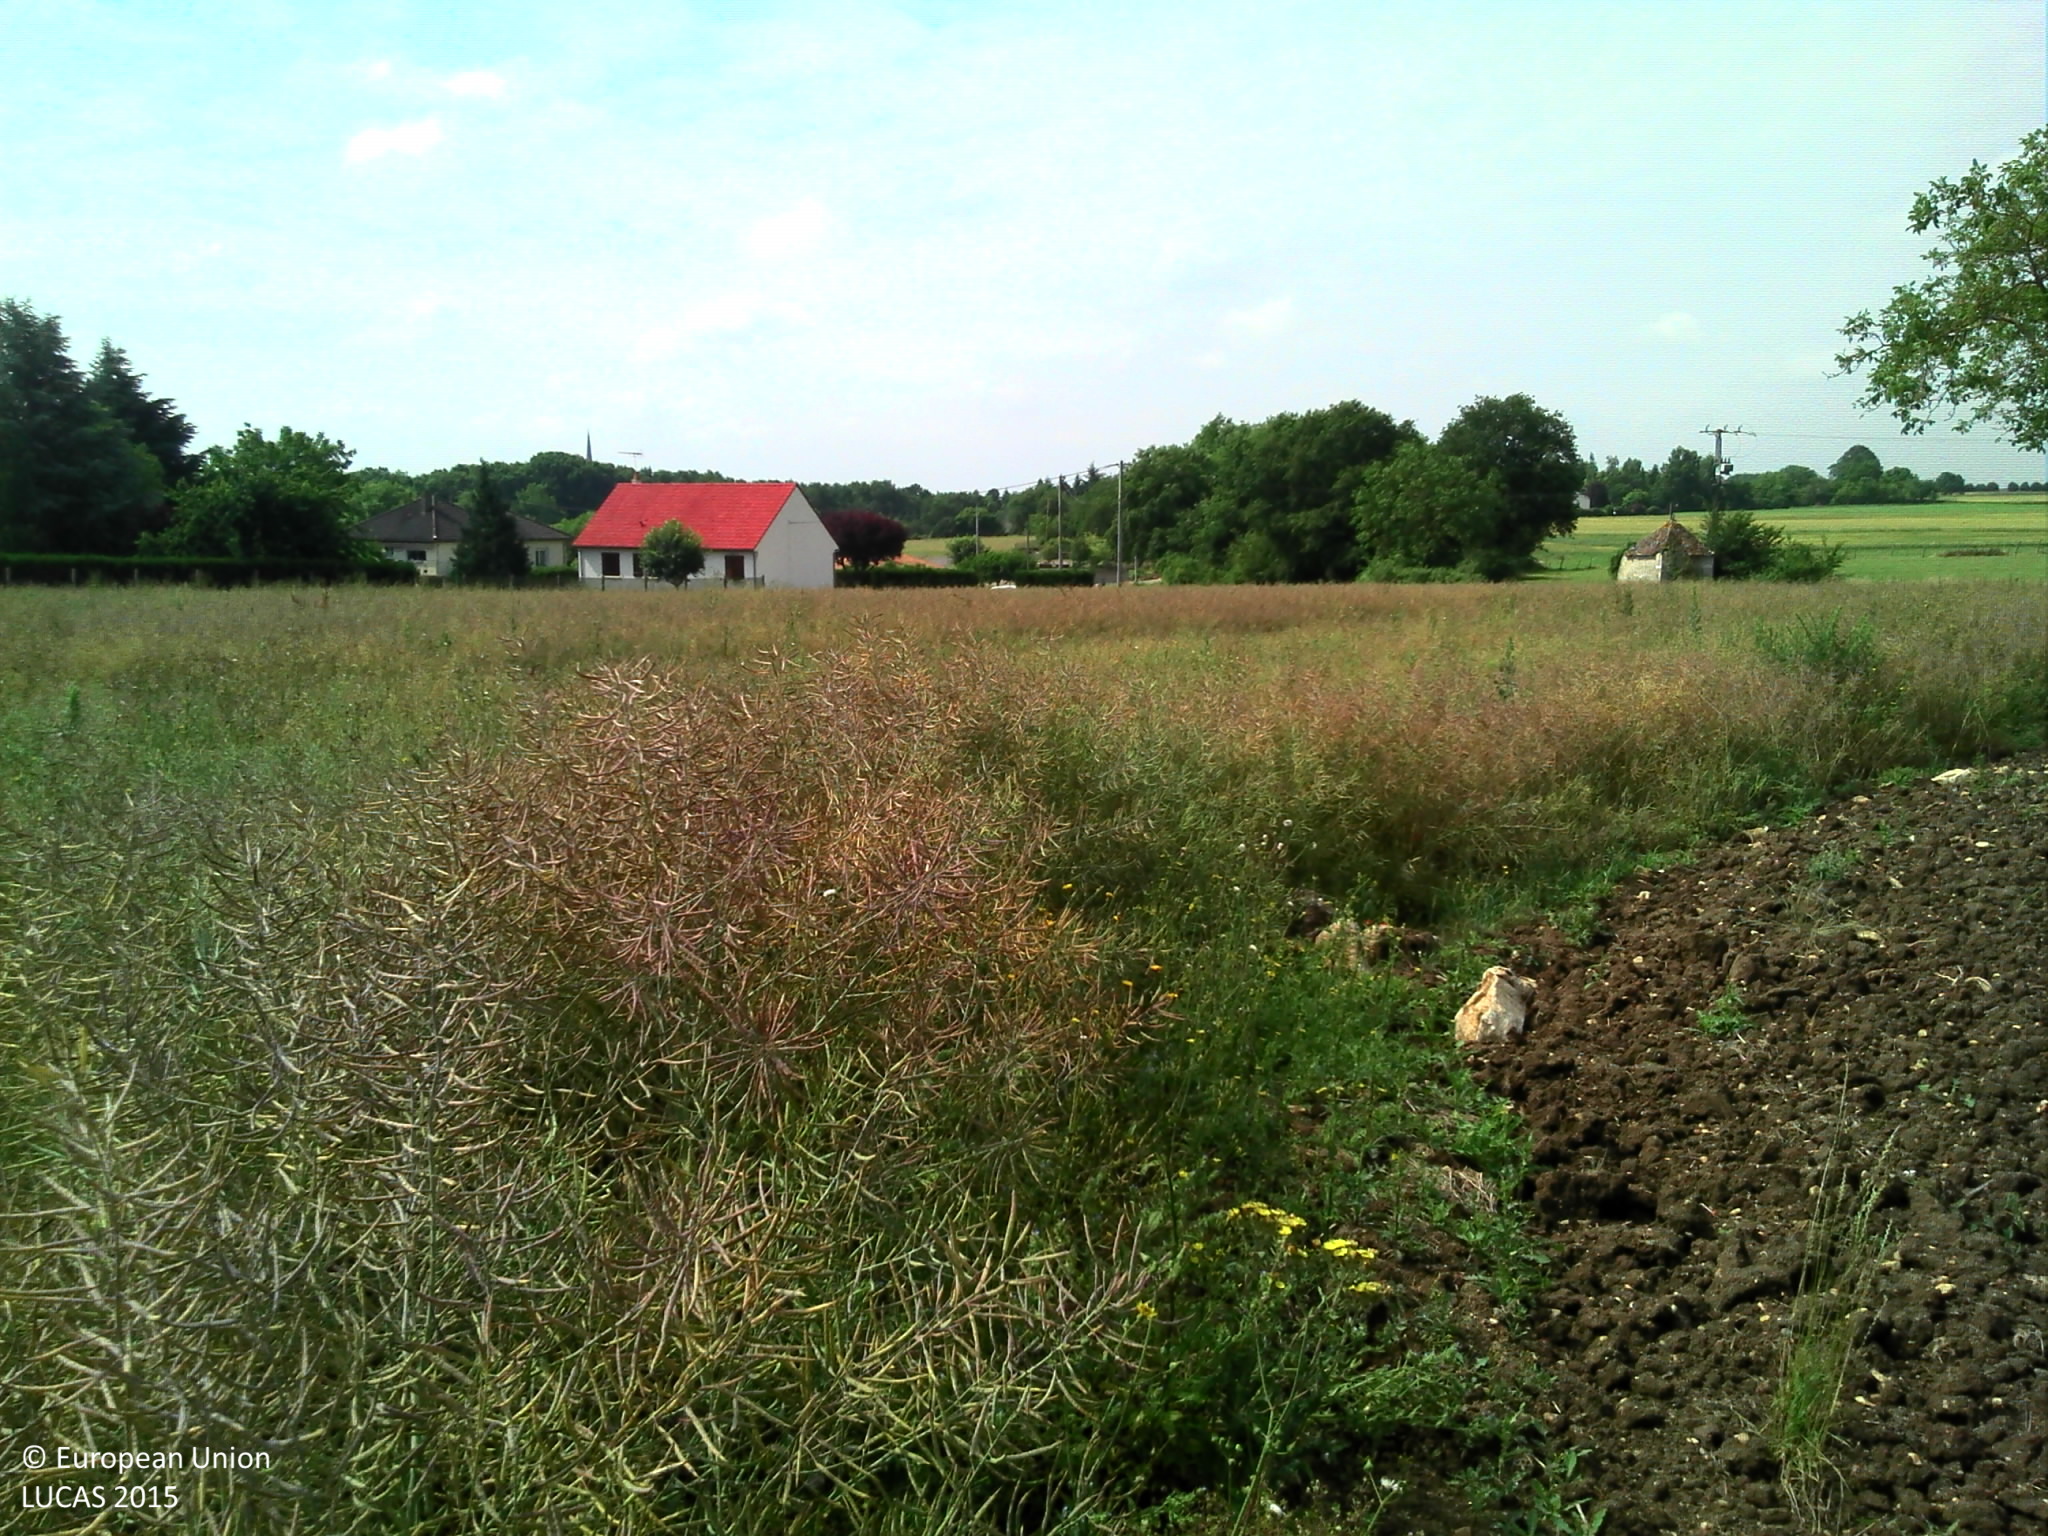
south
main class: Cropland
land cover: Rape and turnip rape
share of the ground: > 75 %
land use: Agriculture (excluding fallow land and kitchen gardens)
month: June
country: FR
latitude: 46.5756
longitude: 0.8643
